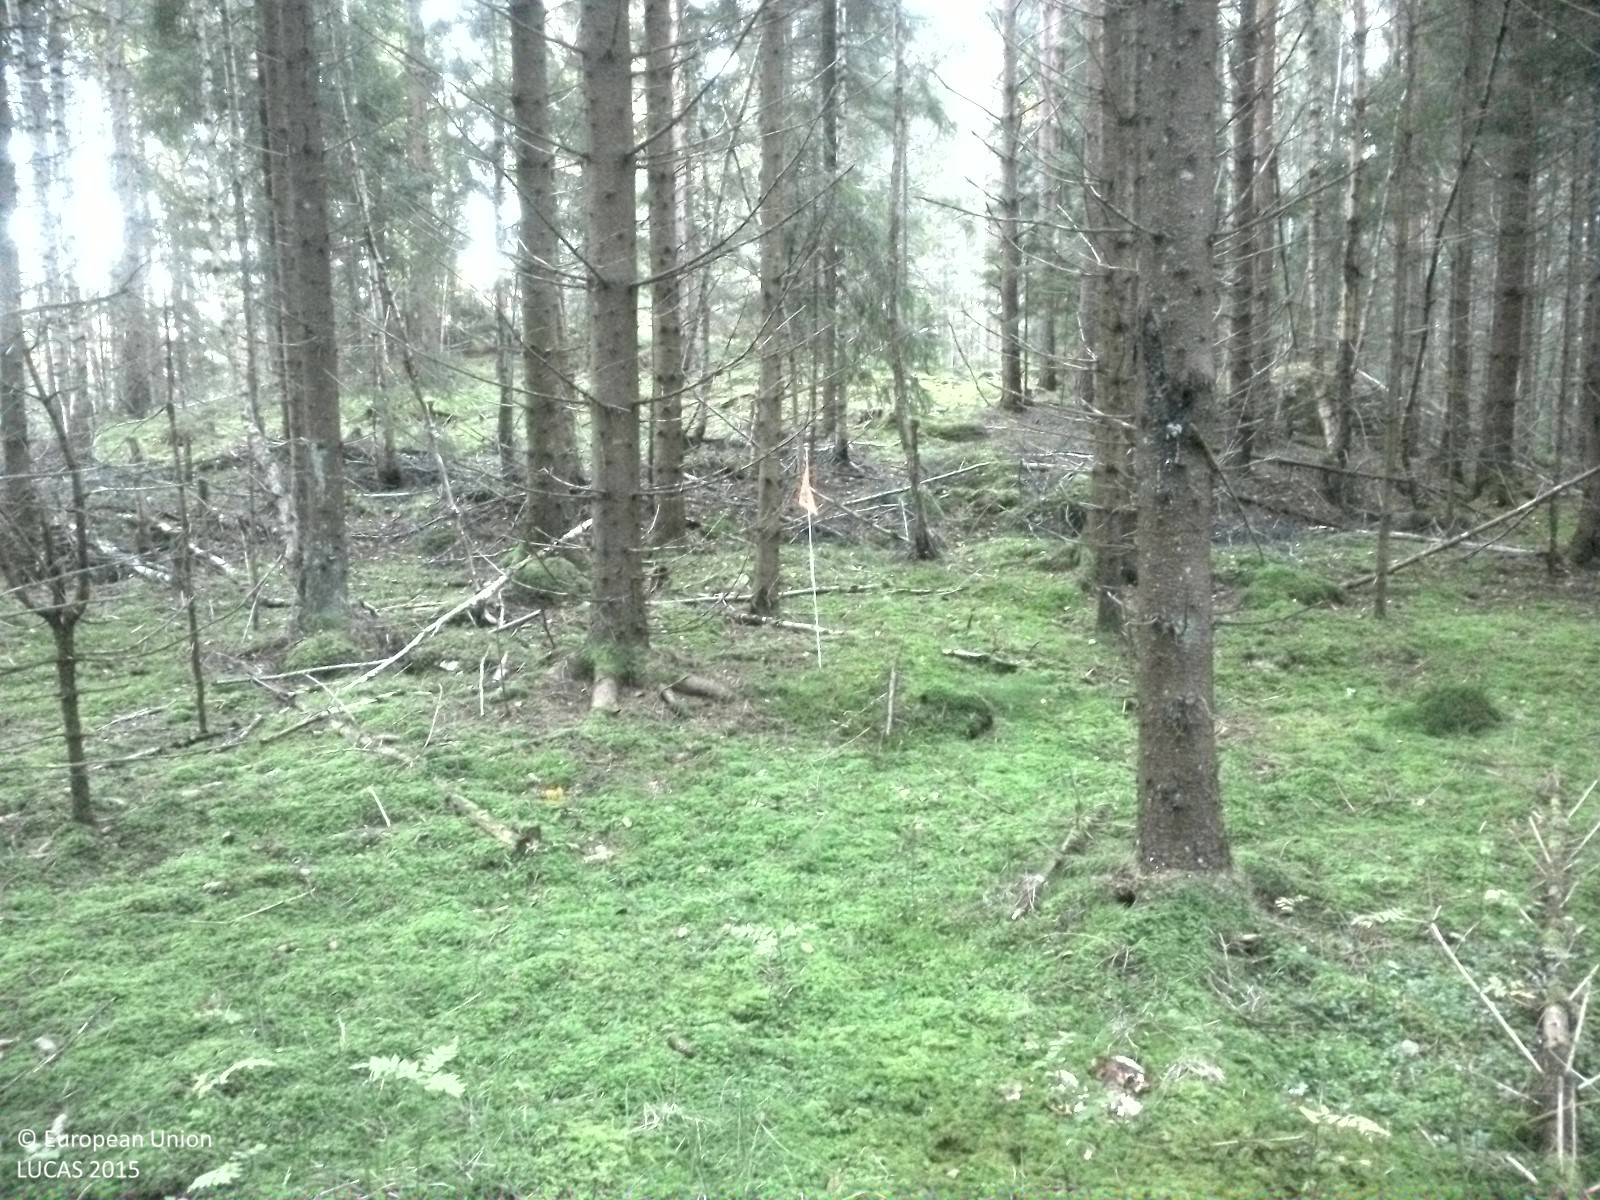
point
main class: Woodland
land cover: Spruce dominated coniferous woodland
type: boreal forest
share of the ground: 50 - 75 %
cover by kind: coniferous forest trees 60 %, lichens and mosses 35 %, herbaceous plants 5 %
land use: Forestry
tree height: > 5 m
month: September
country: SE
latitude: 58.7332
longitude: 16.4383
